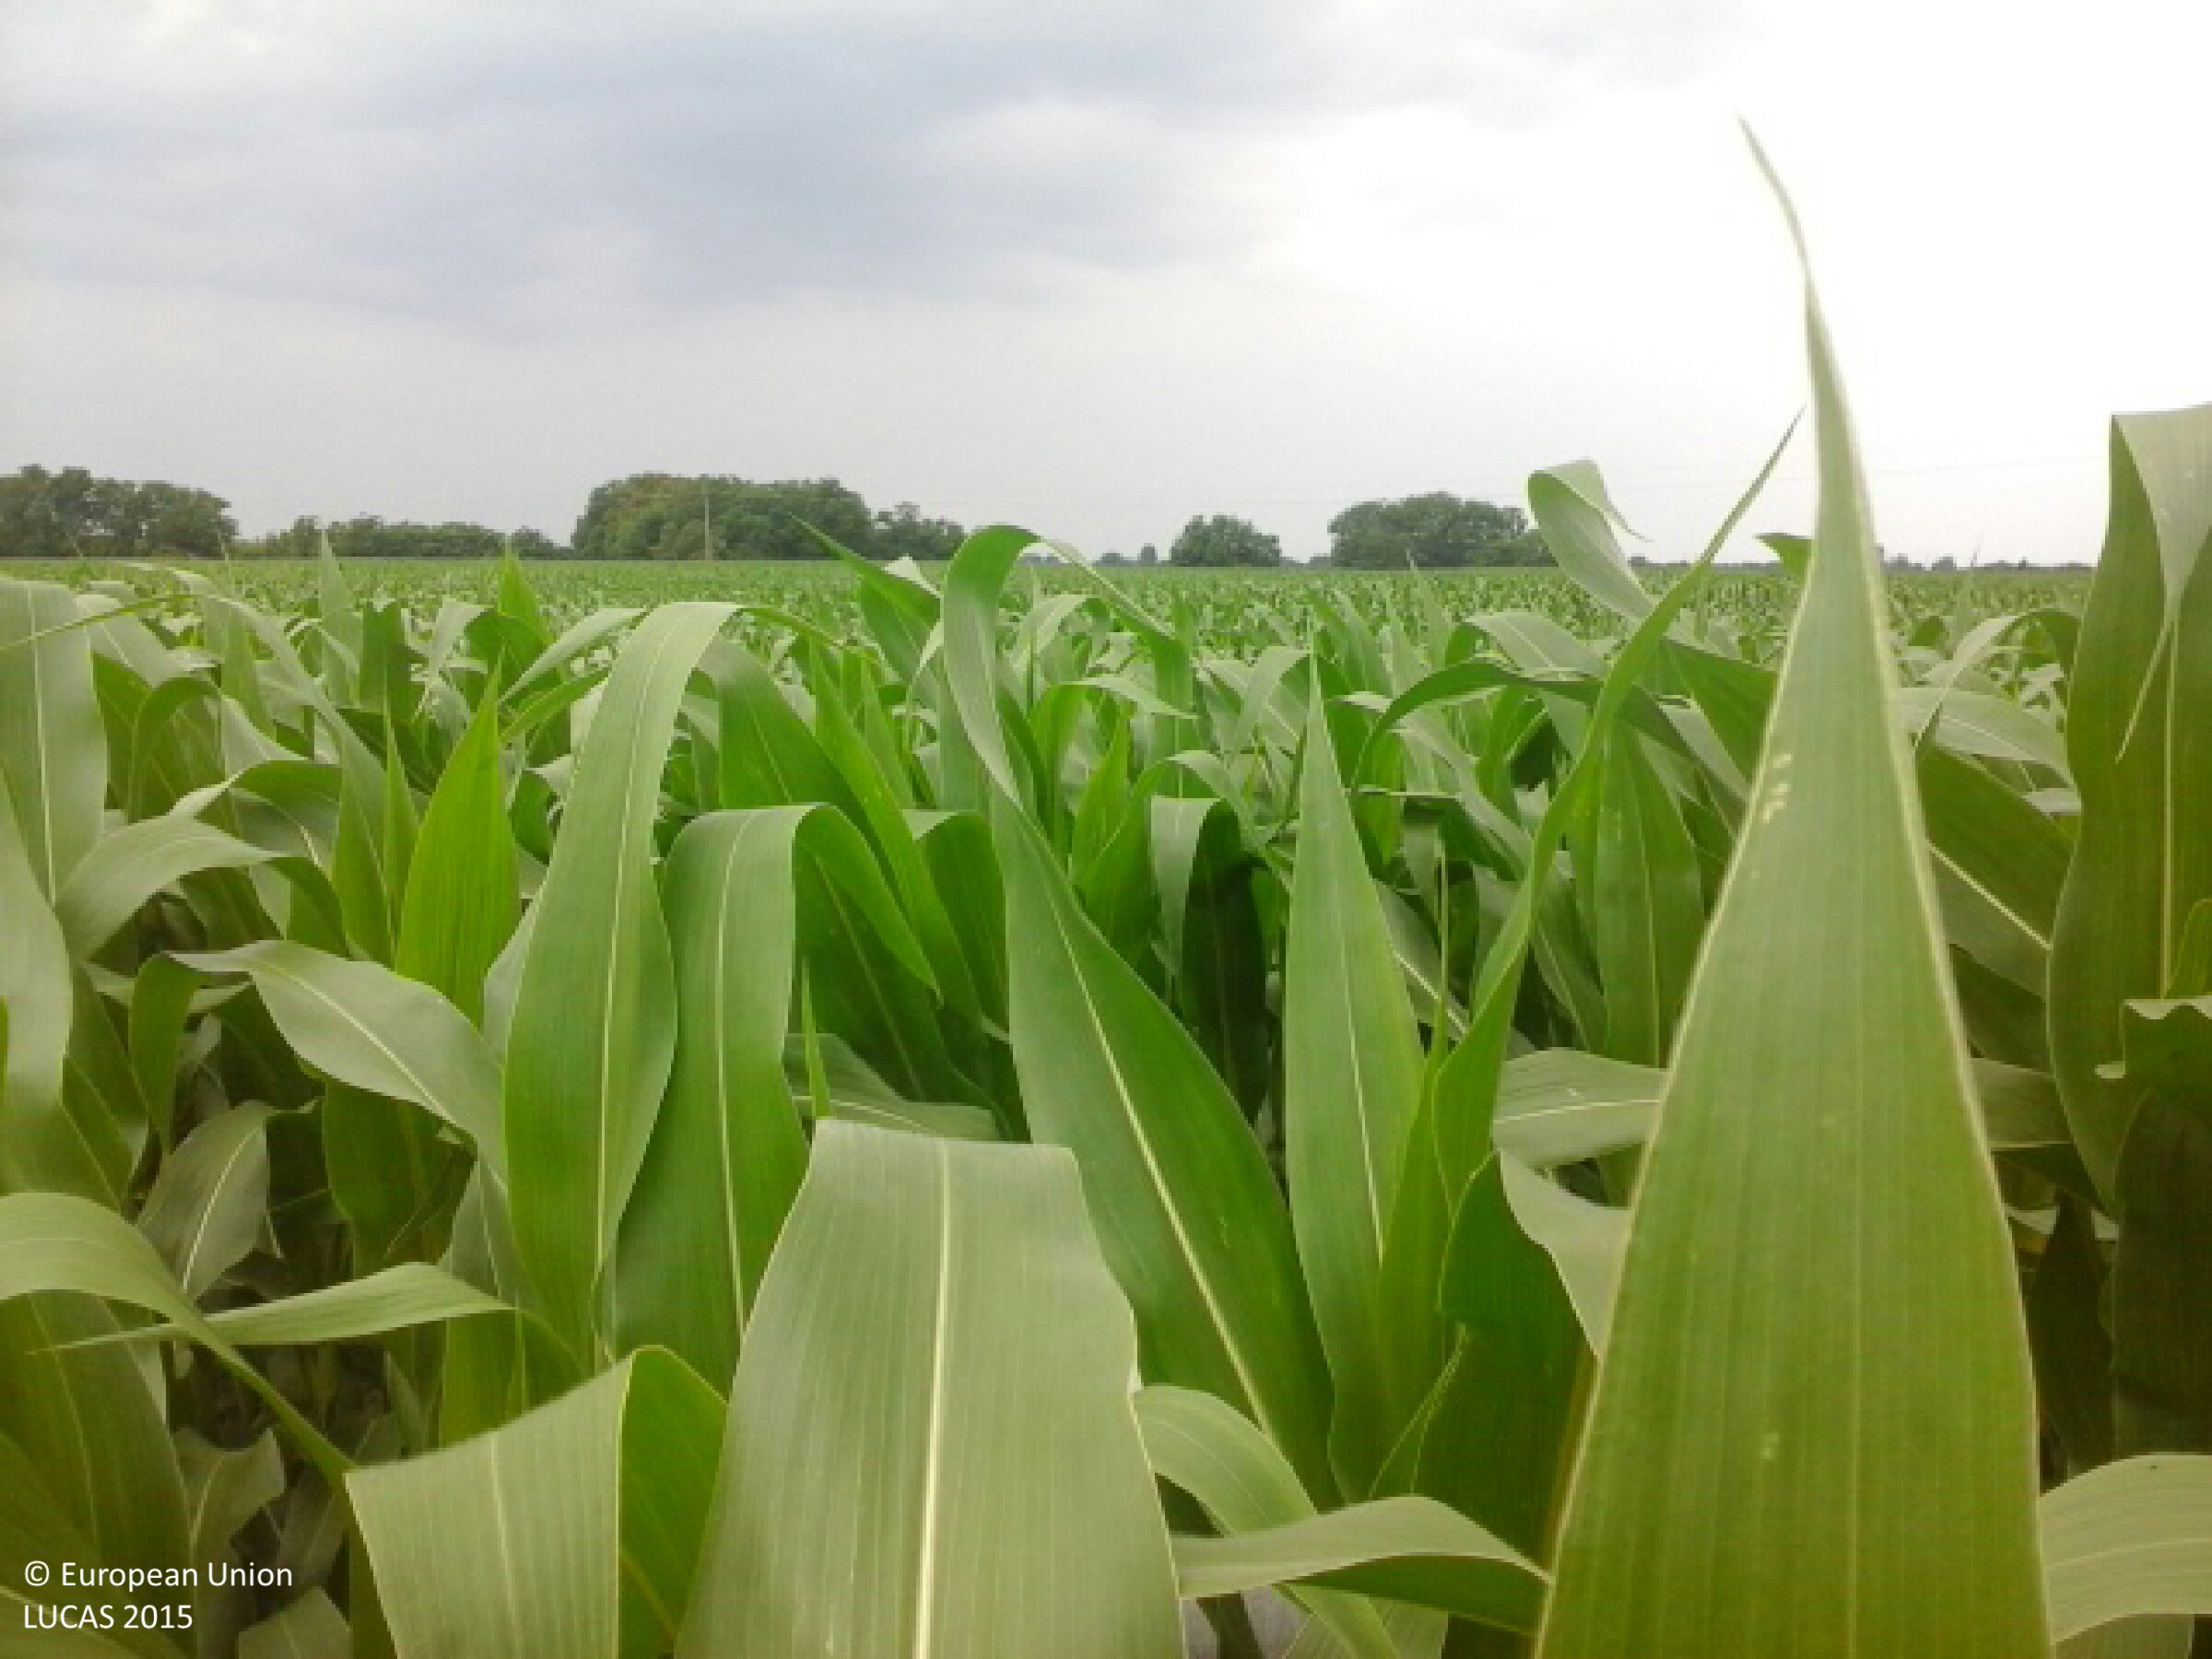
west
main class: Cropland
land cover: Maize
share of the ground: > 75 %
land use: Agriculture (excluding fallow land and kitchen gardens)
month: June
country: HU
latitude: 48.1324
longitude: 21.9707
